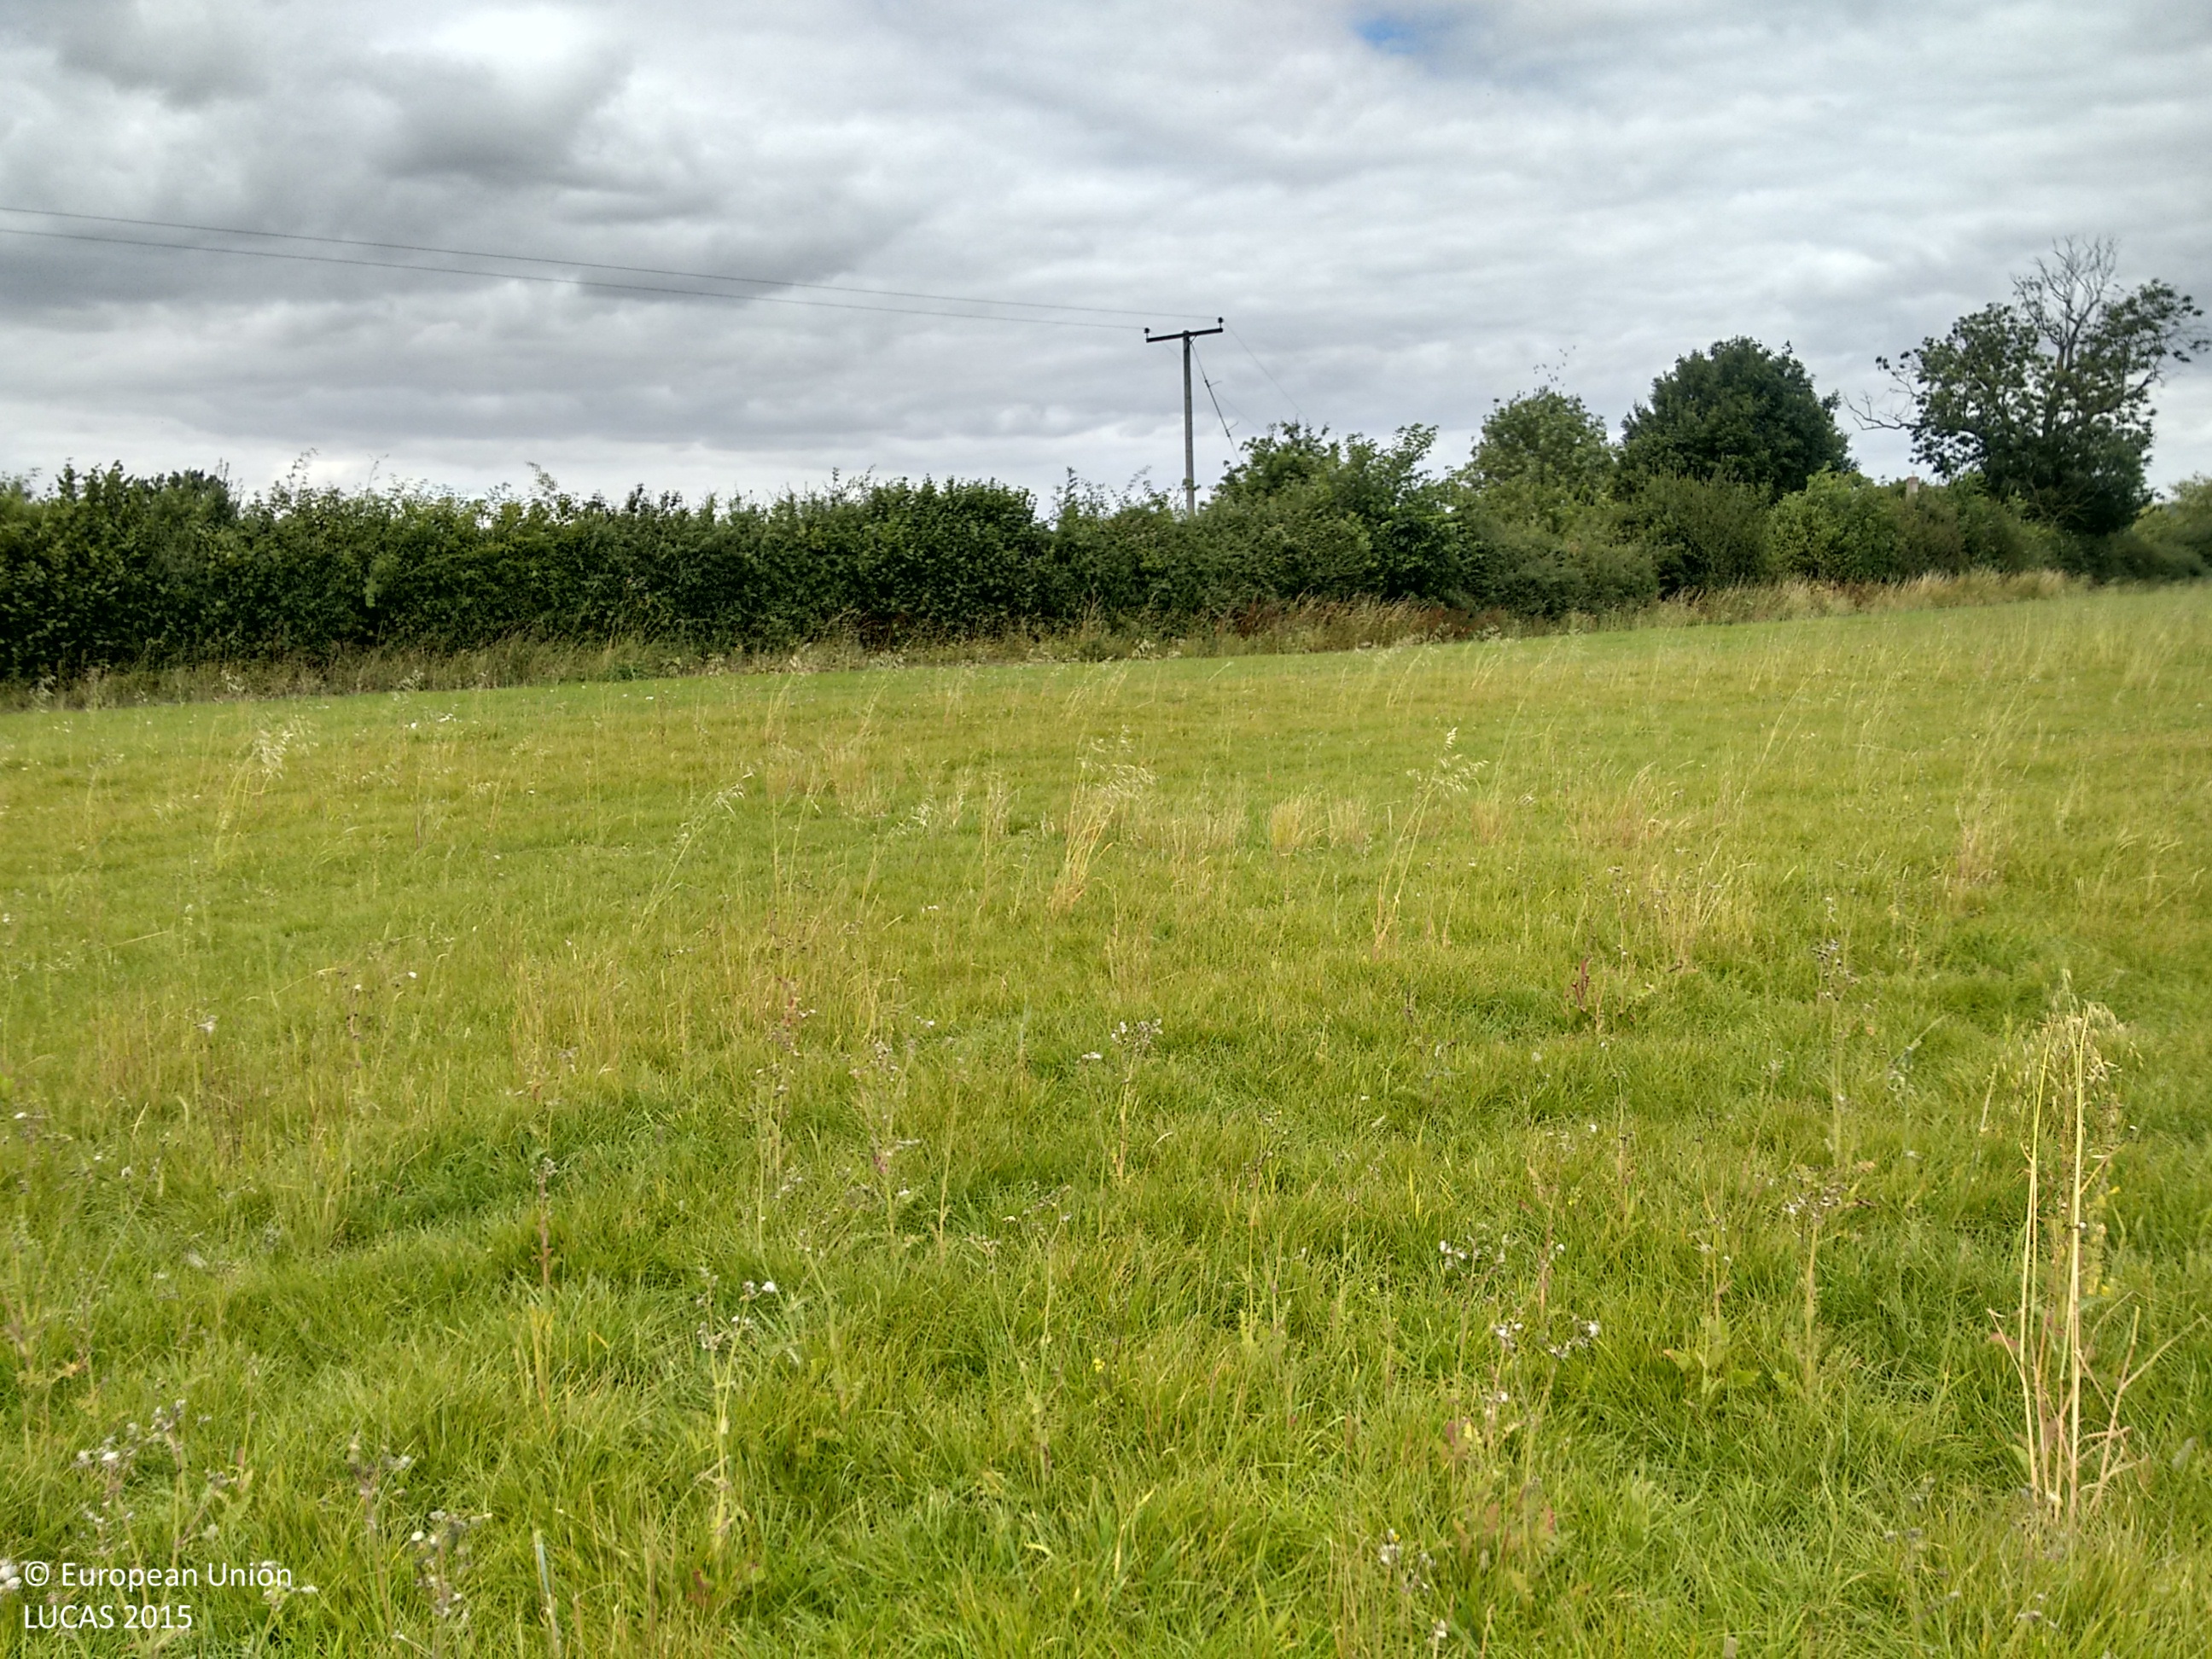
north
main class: Grassland
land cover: Grassland without tree/shrub cover
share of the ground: > 75 %
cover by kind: herbaceous plants 100 %
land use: Agriculture (excluding fallow land and kitchen gardens)
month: August
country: GB
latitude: 52.0057
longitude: 0.4003
